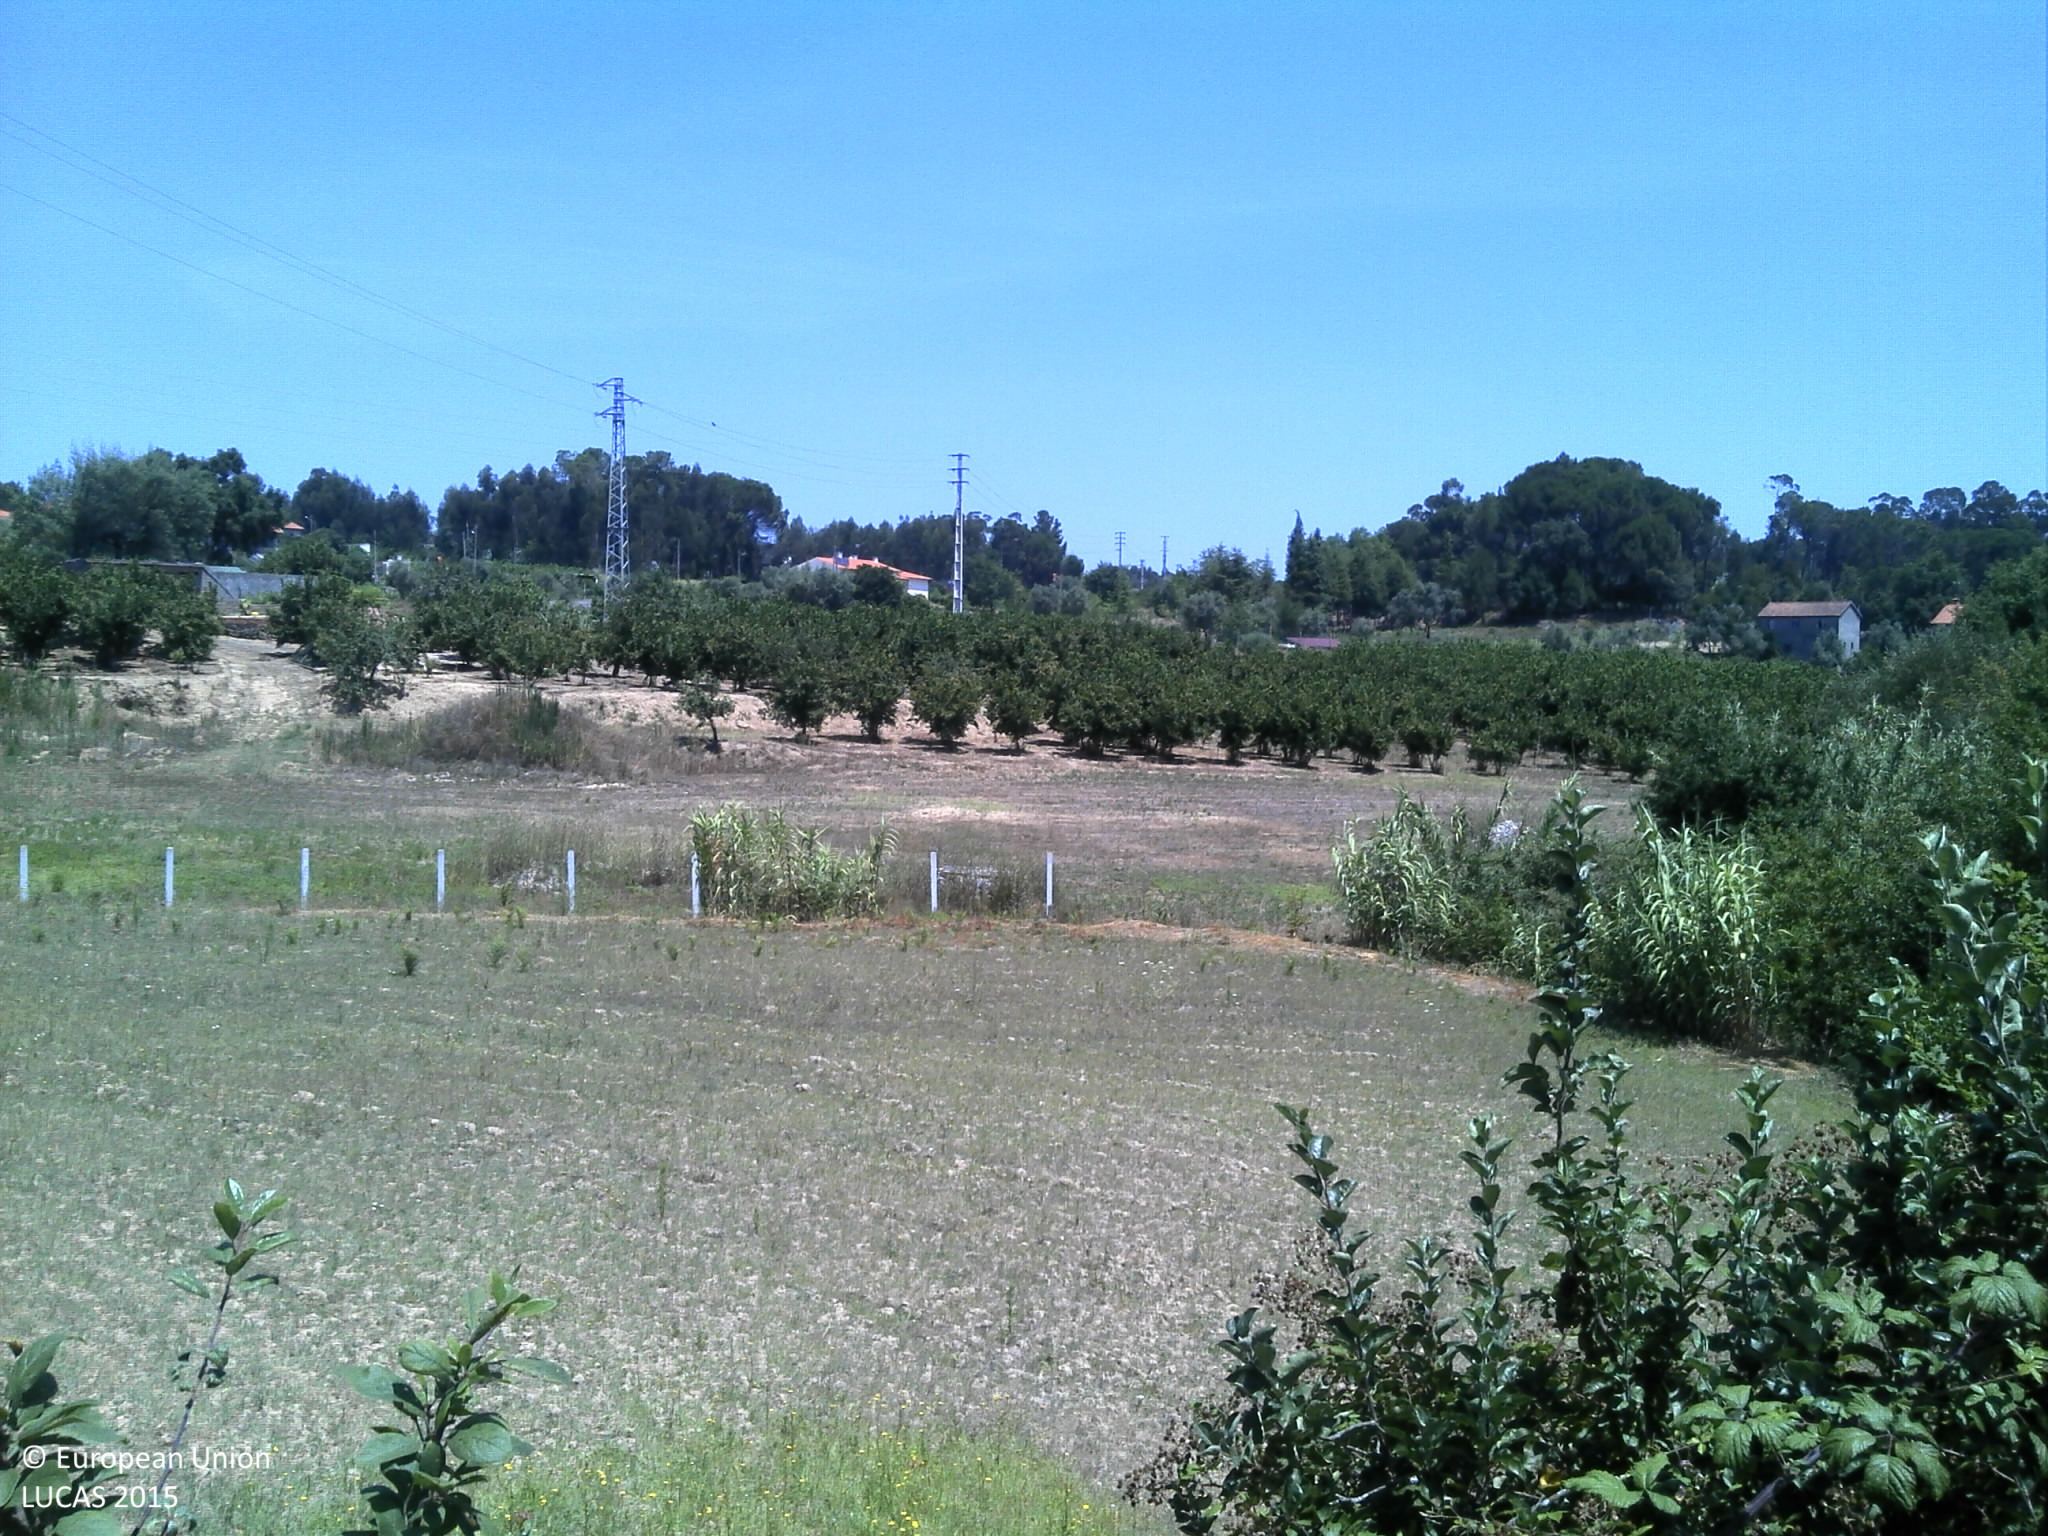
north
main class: Cropland
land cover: Vineyards
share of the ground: < 10 %
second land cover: Grassland without tree/shrub cover
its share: 25 - 50 %
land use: Agriculture (excluding fallow land and kitchen gardens)
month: July
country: PT
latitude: 40.4380
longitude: -7.9826
